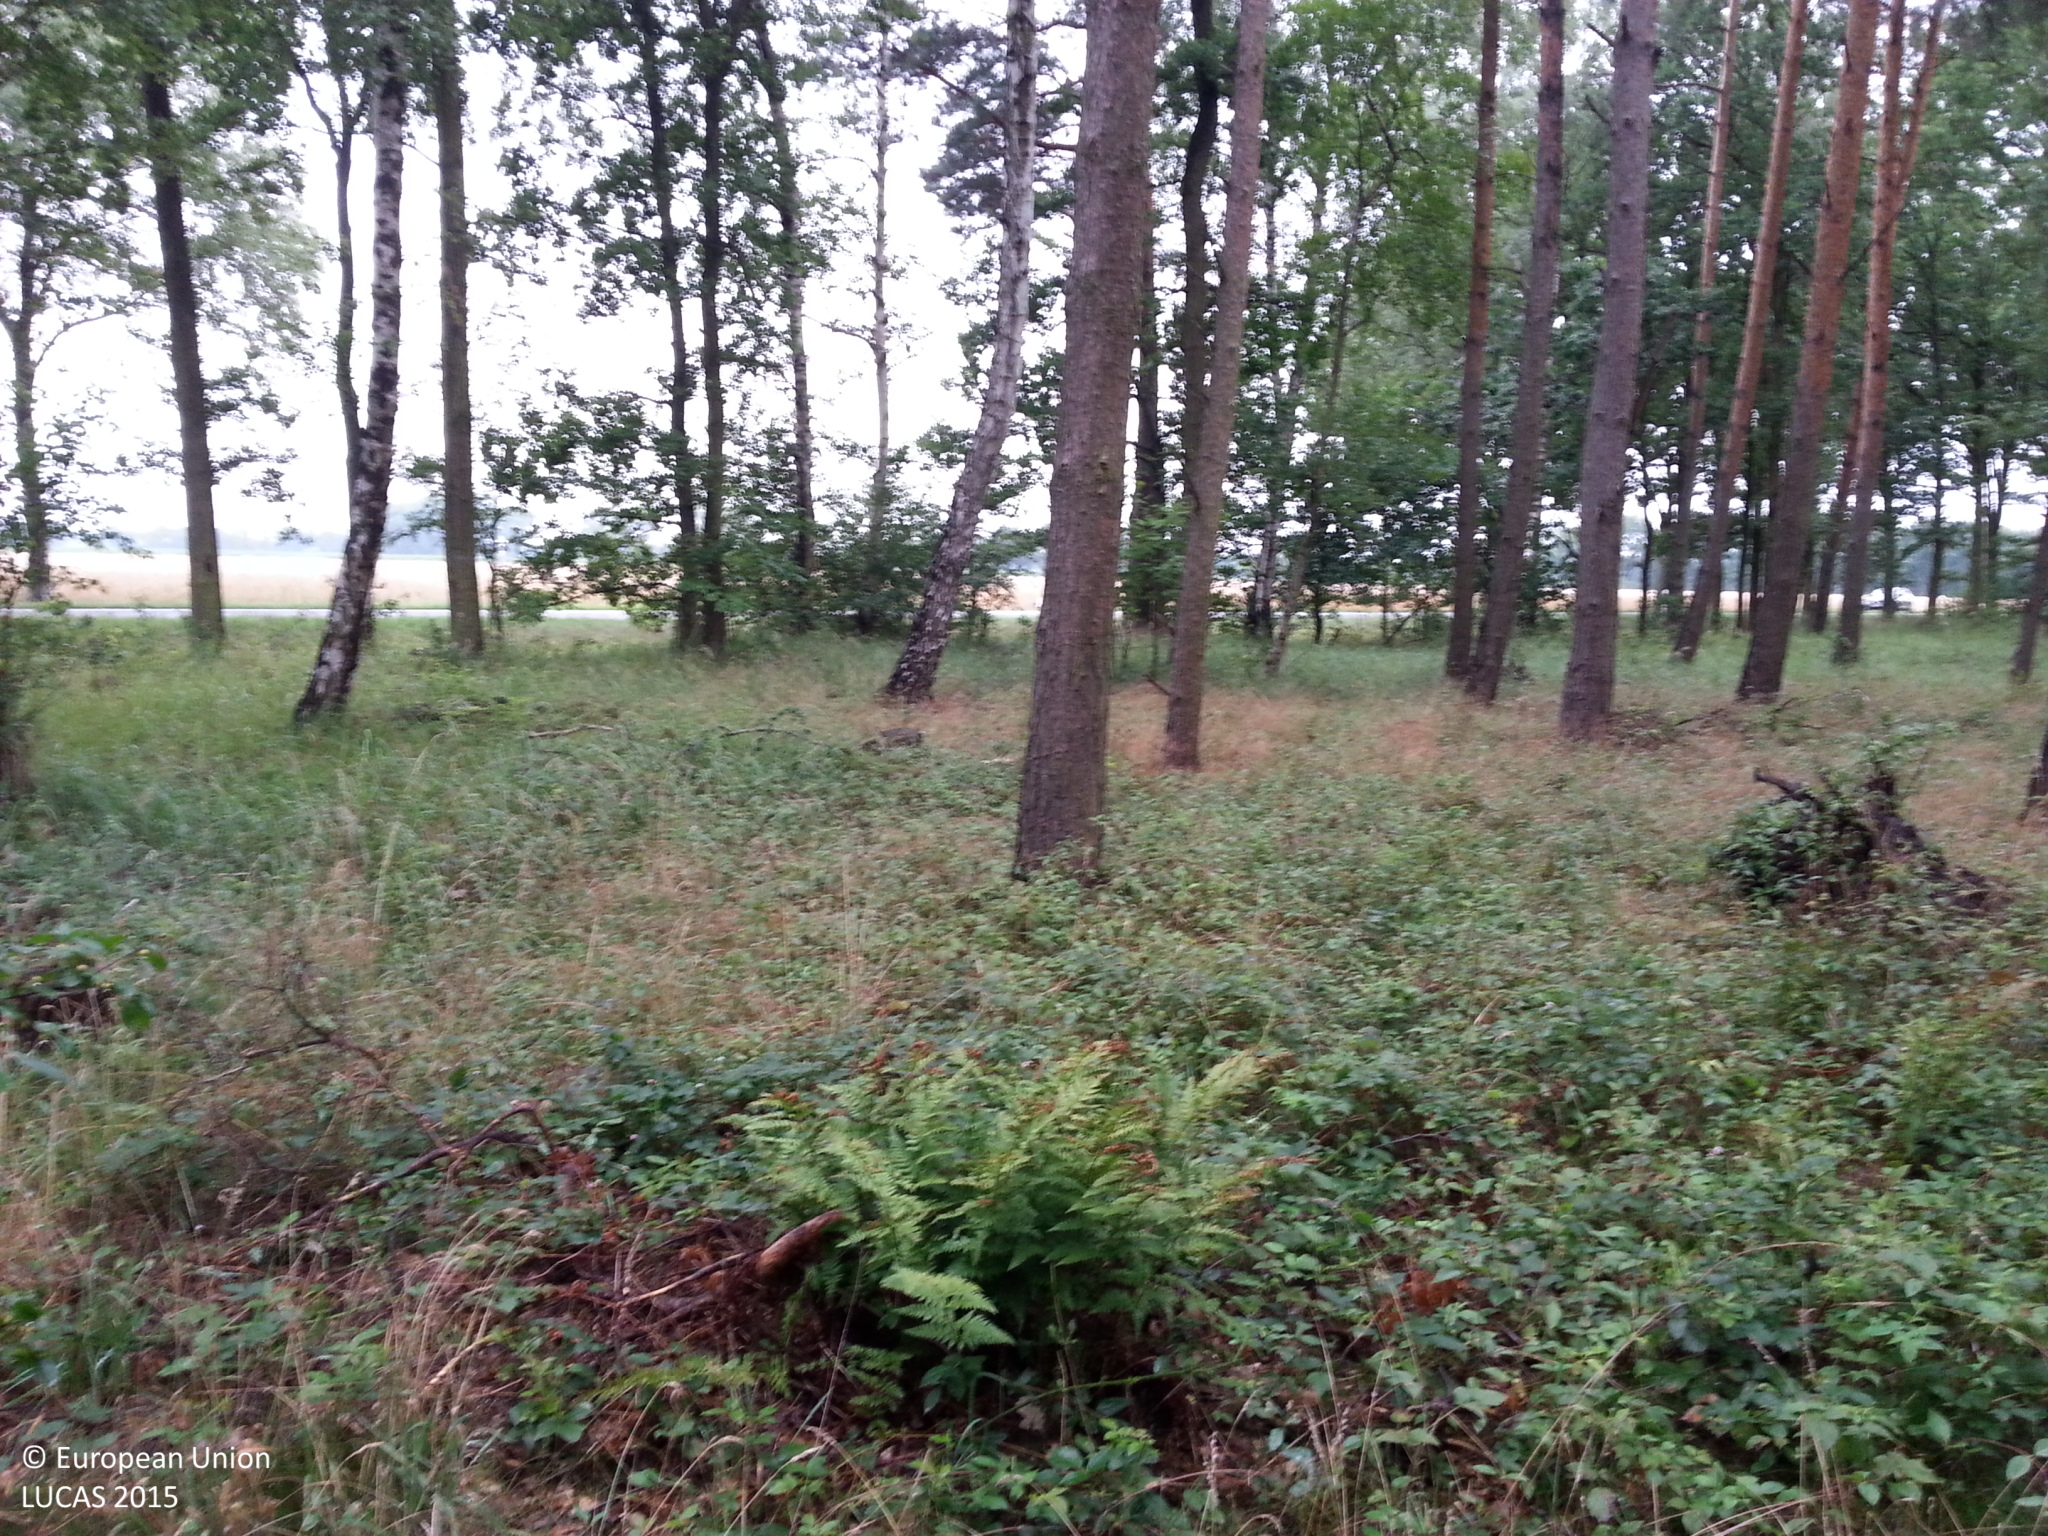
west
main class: Woodland
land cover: Pine dominated mixed woodland
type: hemiboreal forest and nemoral coniferous forest and mixed broadleaved-coniferous forest
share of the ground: 50 - 75 %
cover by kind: coniferous forest trees 40 %, broadleaved forest trees 20 %, herbaceous plants 20 %, shrubs 10 %, lichens and mosses 10 %
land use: Forestry
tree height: > 5 m
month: July
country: DE
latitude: 53.0190
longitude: 11.1474
